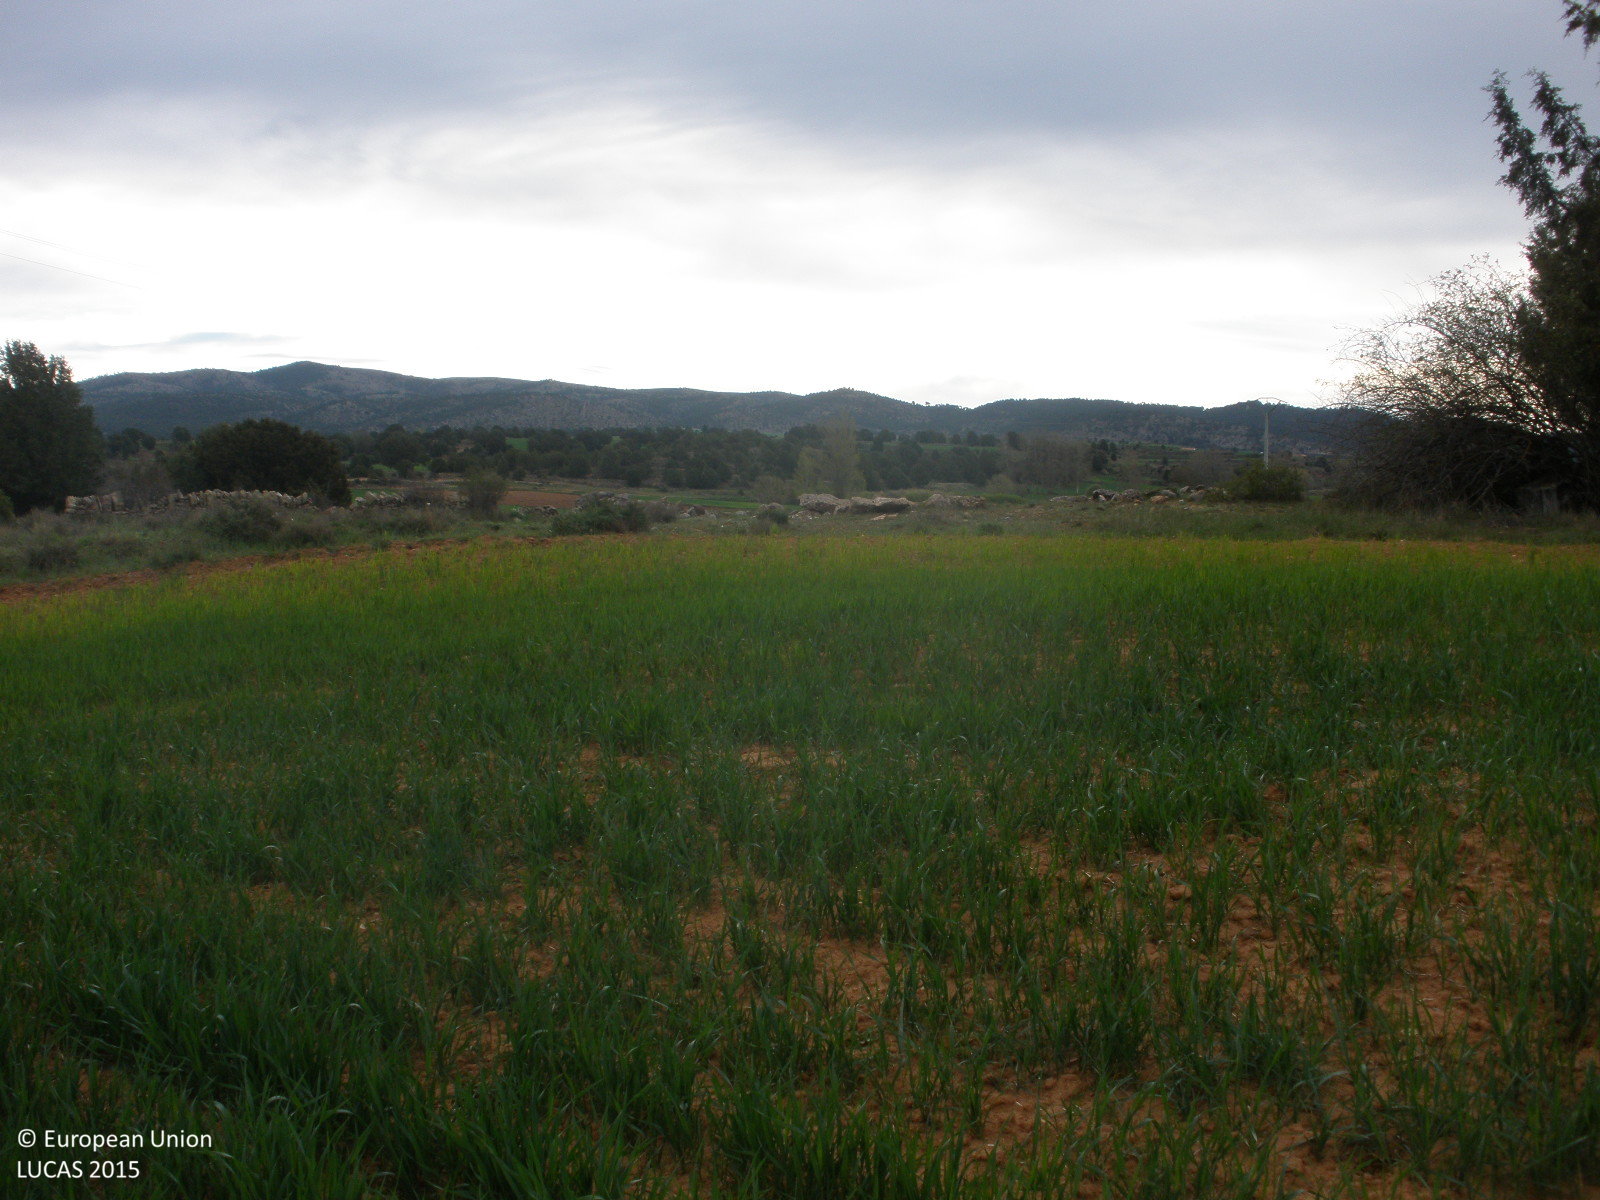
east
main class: Cropland
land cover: Barley
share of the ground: > 75 %
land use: Agriculture (excluding fallow land and kitchen gardens)
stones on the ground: < 10 %
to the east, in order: Barley; Shrubland with sparse tree cover; Barley; Dry stone walls; Barley; Grass margins; Electric lines; Common wheat; Grass margins; Common wheat; Grass margins; Common wheat; Grass margins; Common wheat; Grass margins; Tracks; Shrubland without tree cover; Barley
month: May
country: ES
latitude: 40.4124
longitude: -1.0055
